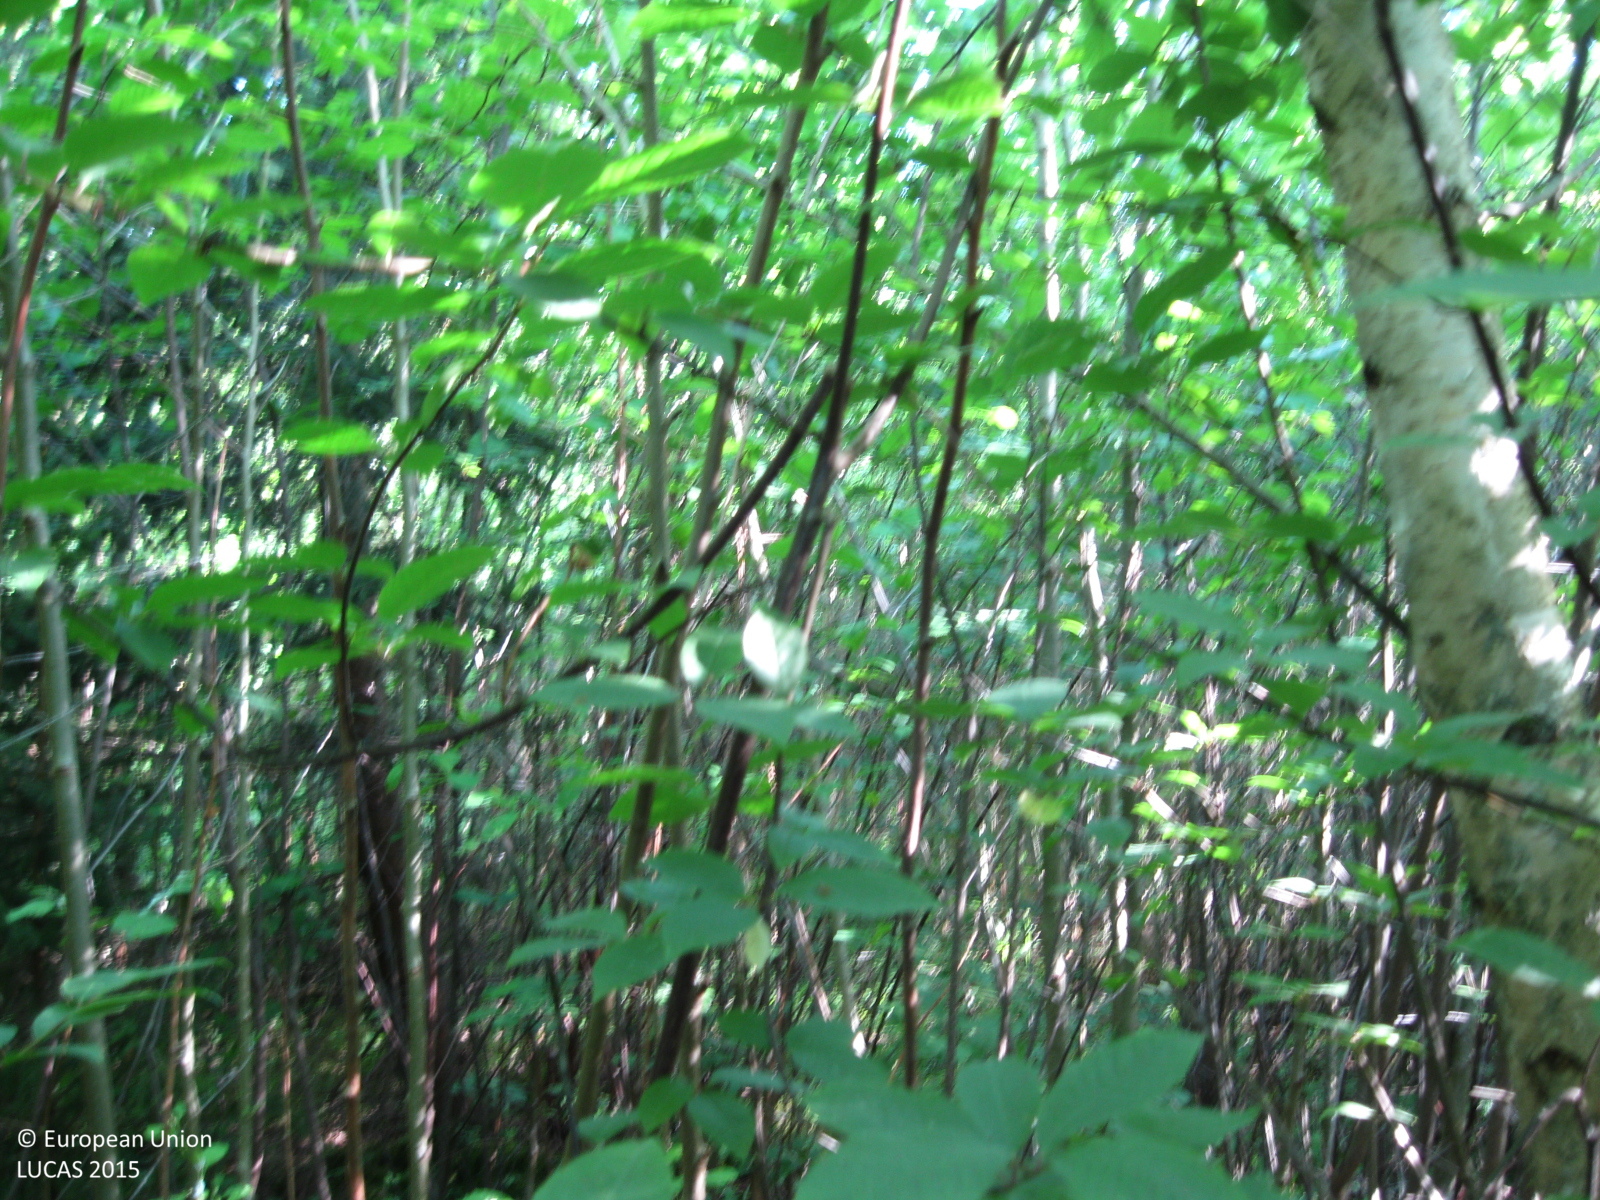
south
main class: Woodland
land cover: Spruce dominated mixed woodland
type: hemiboreal forest and nemoral coniferous forest and mixed broadleaved-coniferous forest
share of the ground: > 75 %
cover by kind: broadleaved forest trees 60 %, coniferous forest trees 30 %, herbaceous plants 10 %
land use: Forestry
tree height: > 5 m
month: June
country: LT
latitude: 55.5678
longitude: 23.6078
